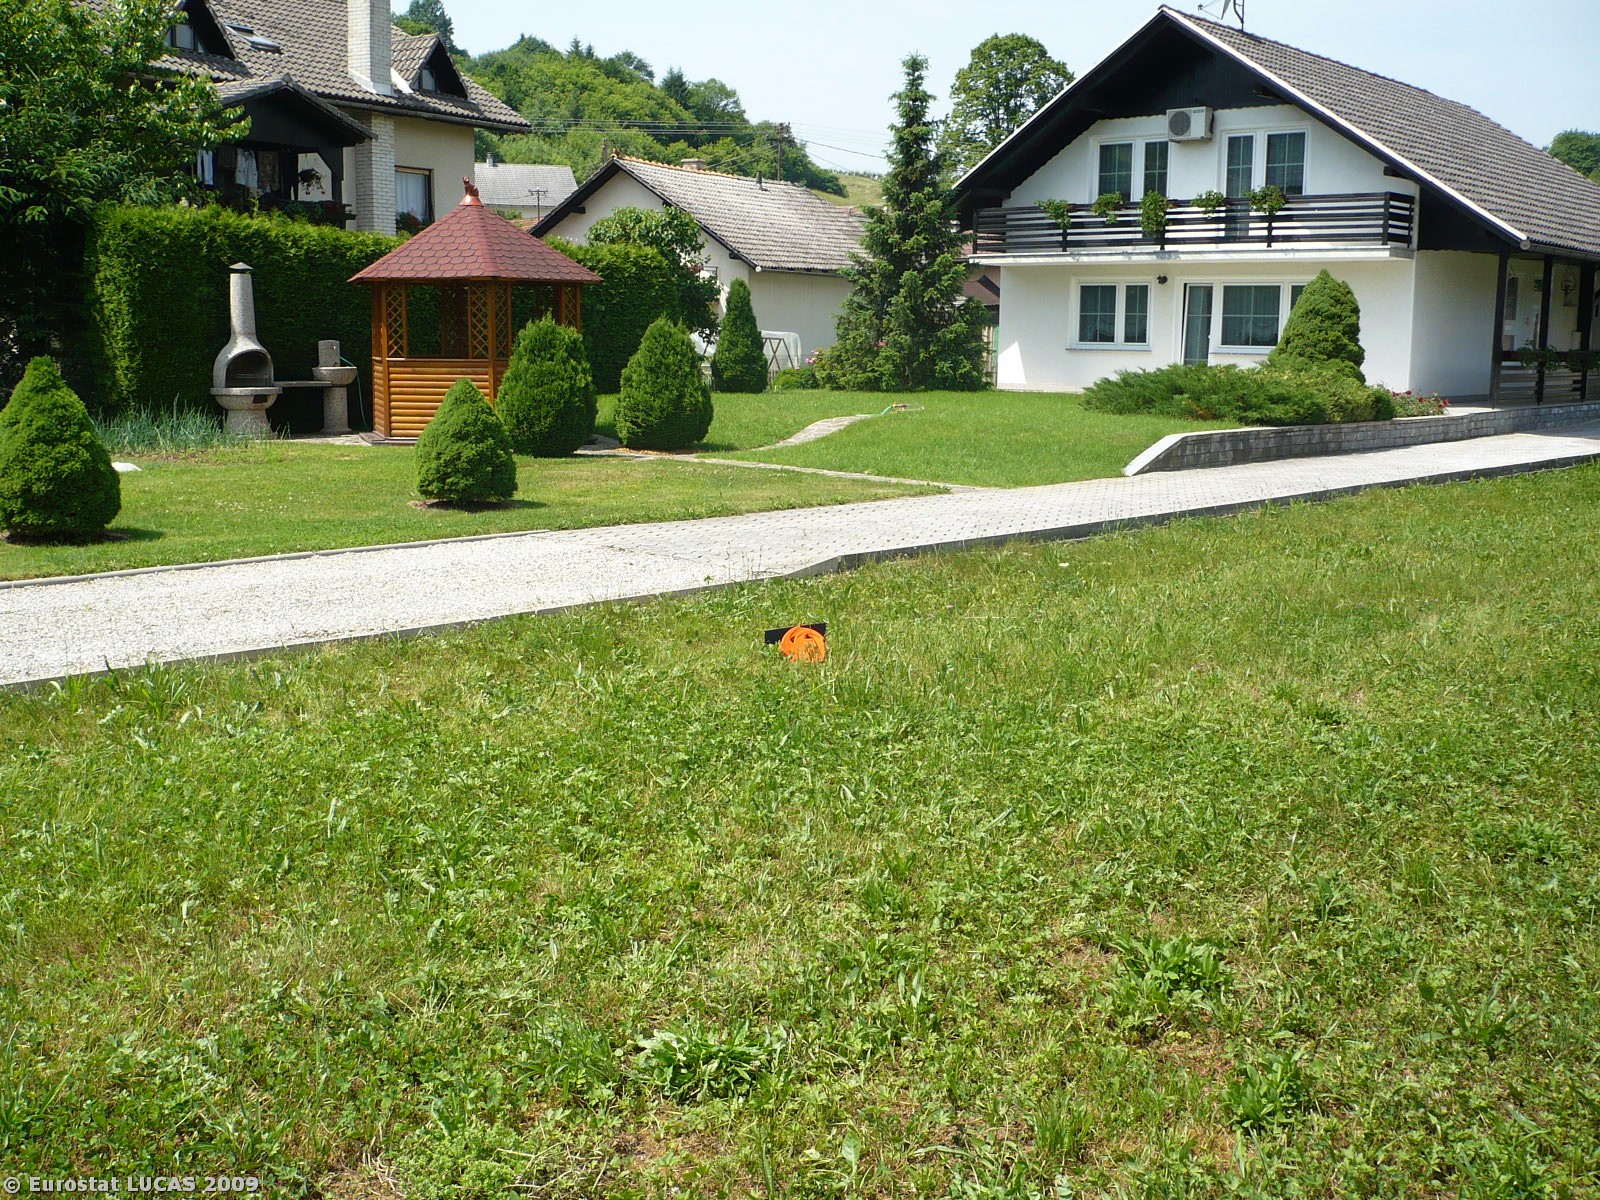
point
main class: Grassland
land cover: Grassland with sparse tree/shrub cover
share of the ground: > 75 %
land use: Agriculture (excluding fallow land and kitchen gardens)
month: May
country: SI
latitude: 45.8067
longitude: 15.2596
